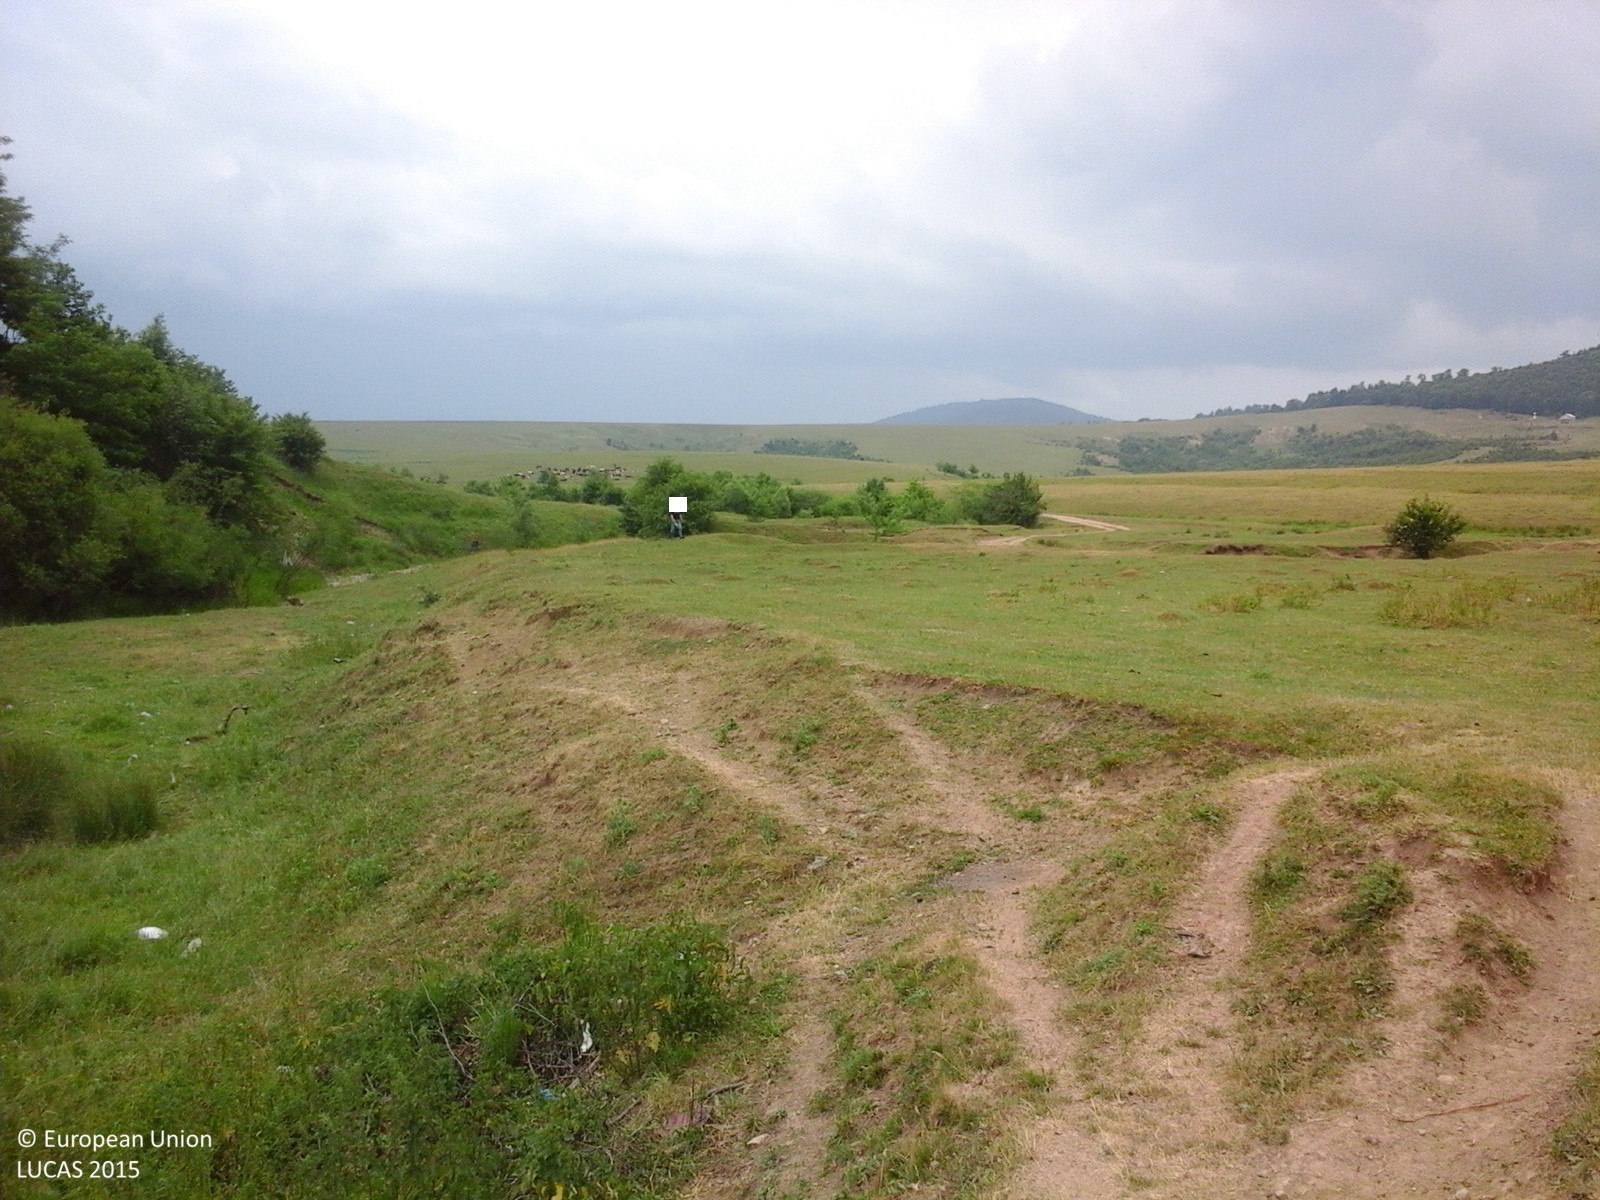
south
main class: Grassland
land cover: Grassland without tree/shrub cover
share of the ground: > 75 %
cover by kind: herbaceous plants 100 %
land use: Agriculture (excluding fallow land and kitchen gardens)
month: June
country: RO
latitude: 47.2046
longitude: 26.2792
